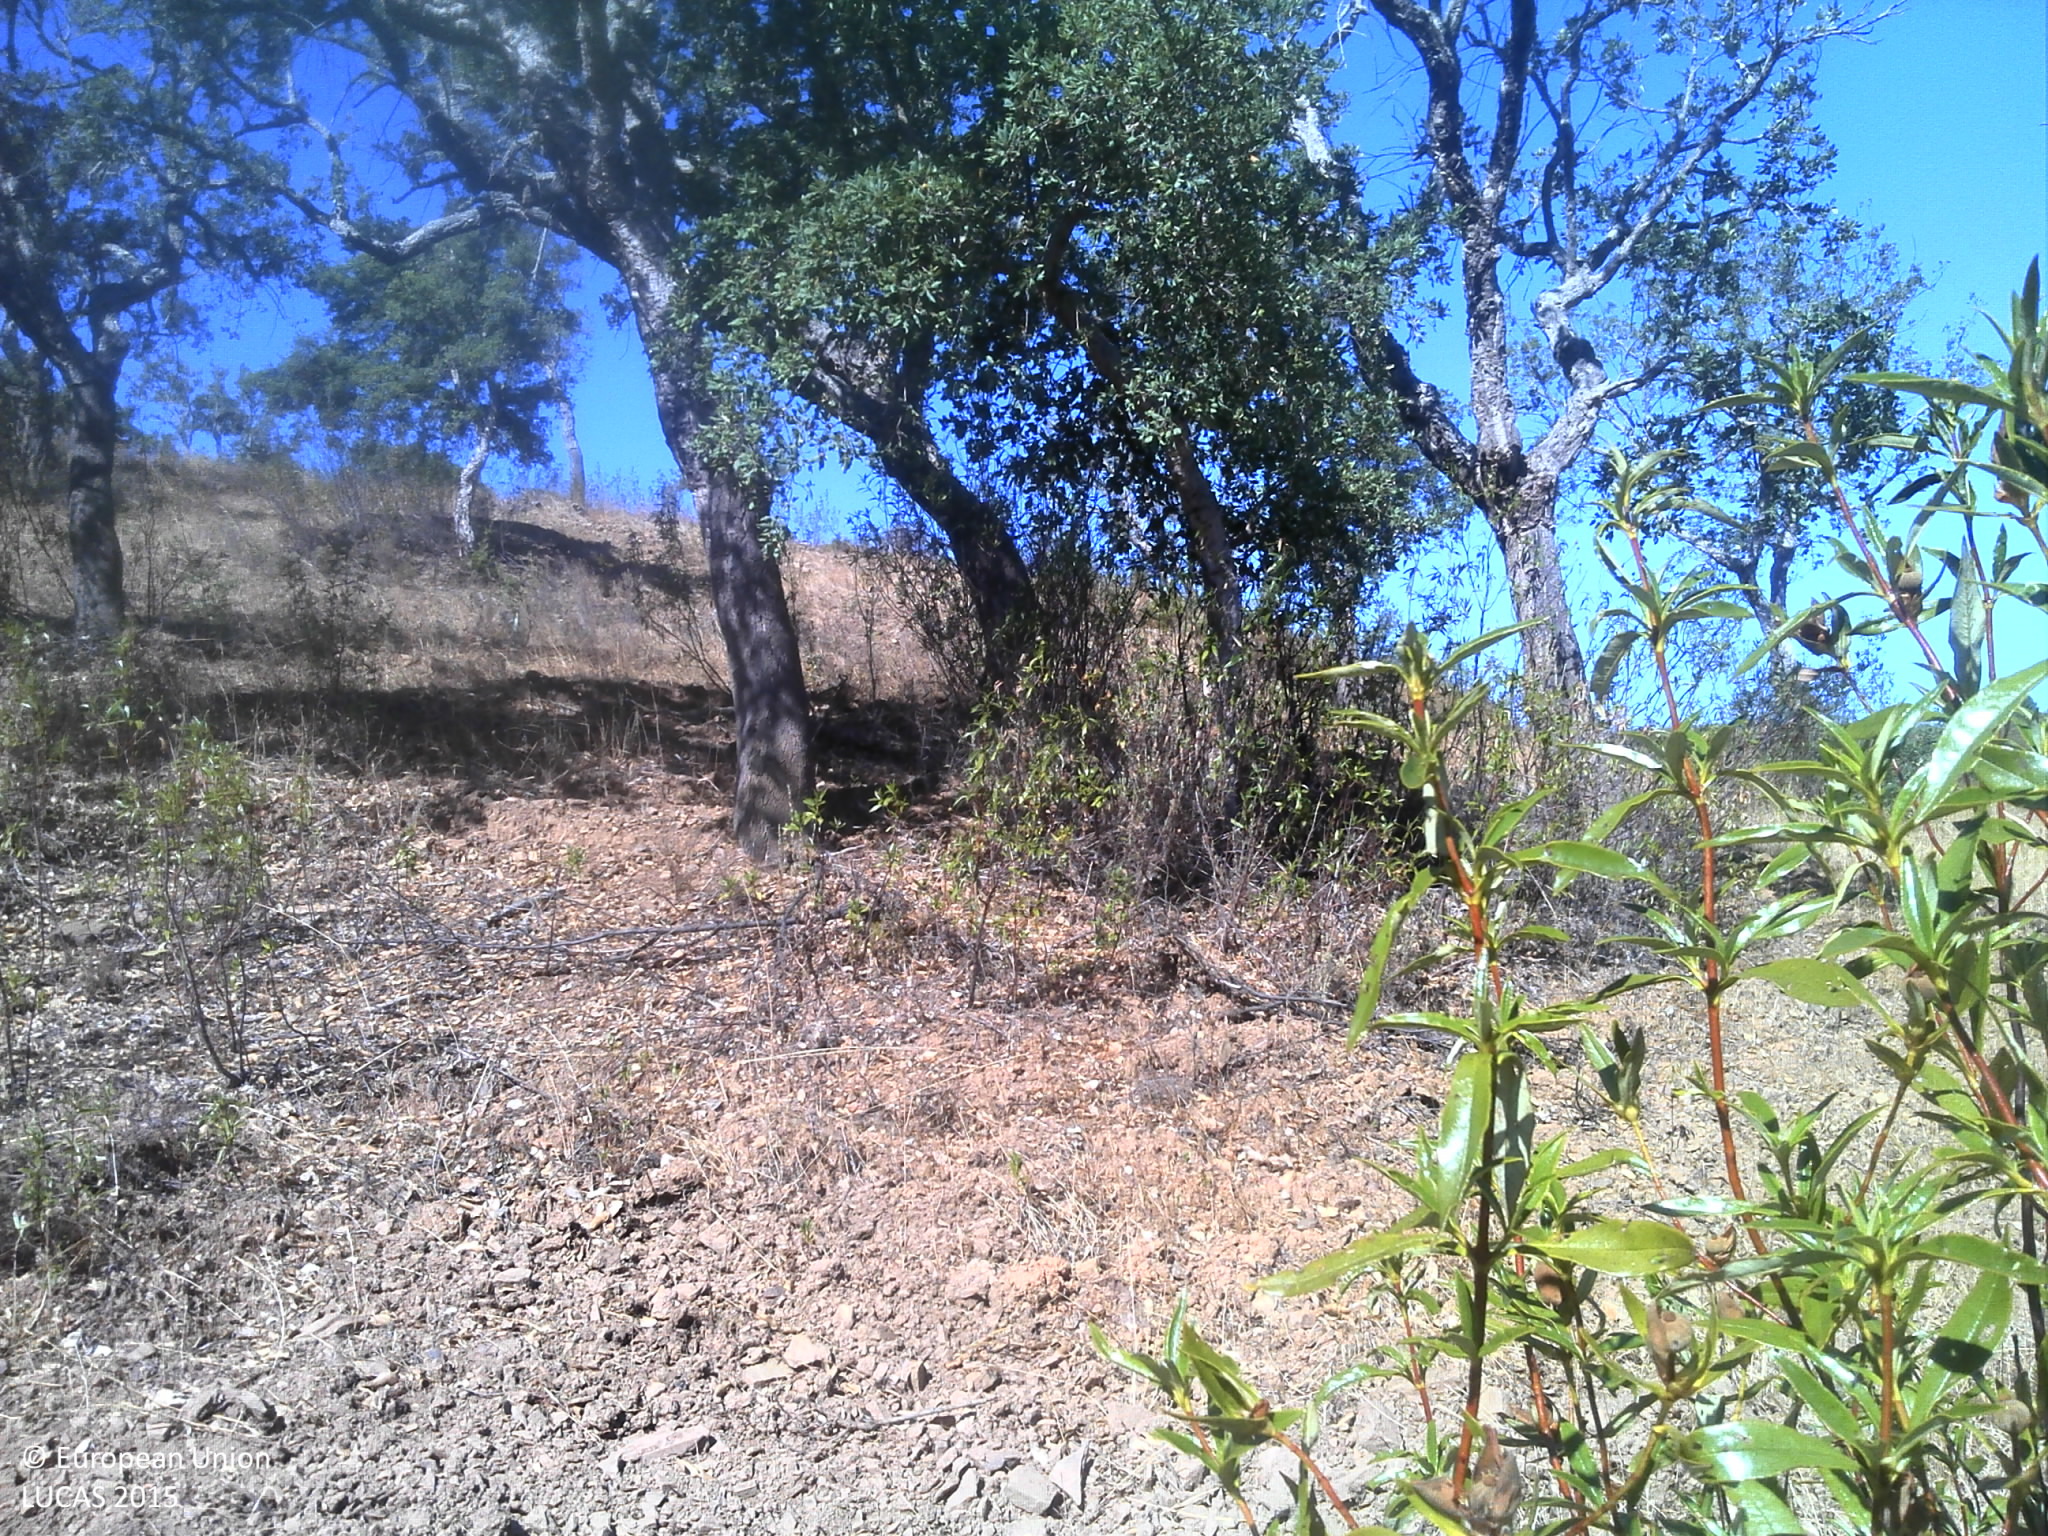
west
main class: Woodland
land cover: Broadleaved woodland
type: broadleaved evergreen forest
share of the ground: 25 - 50 %
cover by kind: unconsolidated bare surface 40 %, broadleaved forest trees 30 %, shrubs 30 %
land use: Forestry
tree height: > 5 m
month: August
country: PT
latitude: 37.1831
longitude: -8.7412
